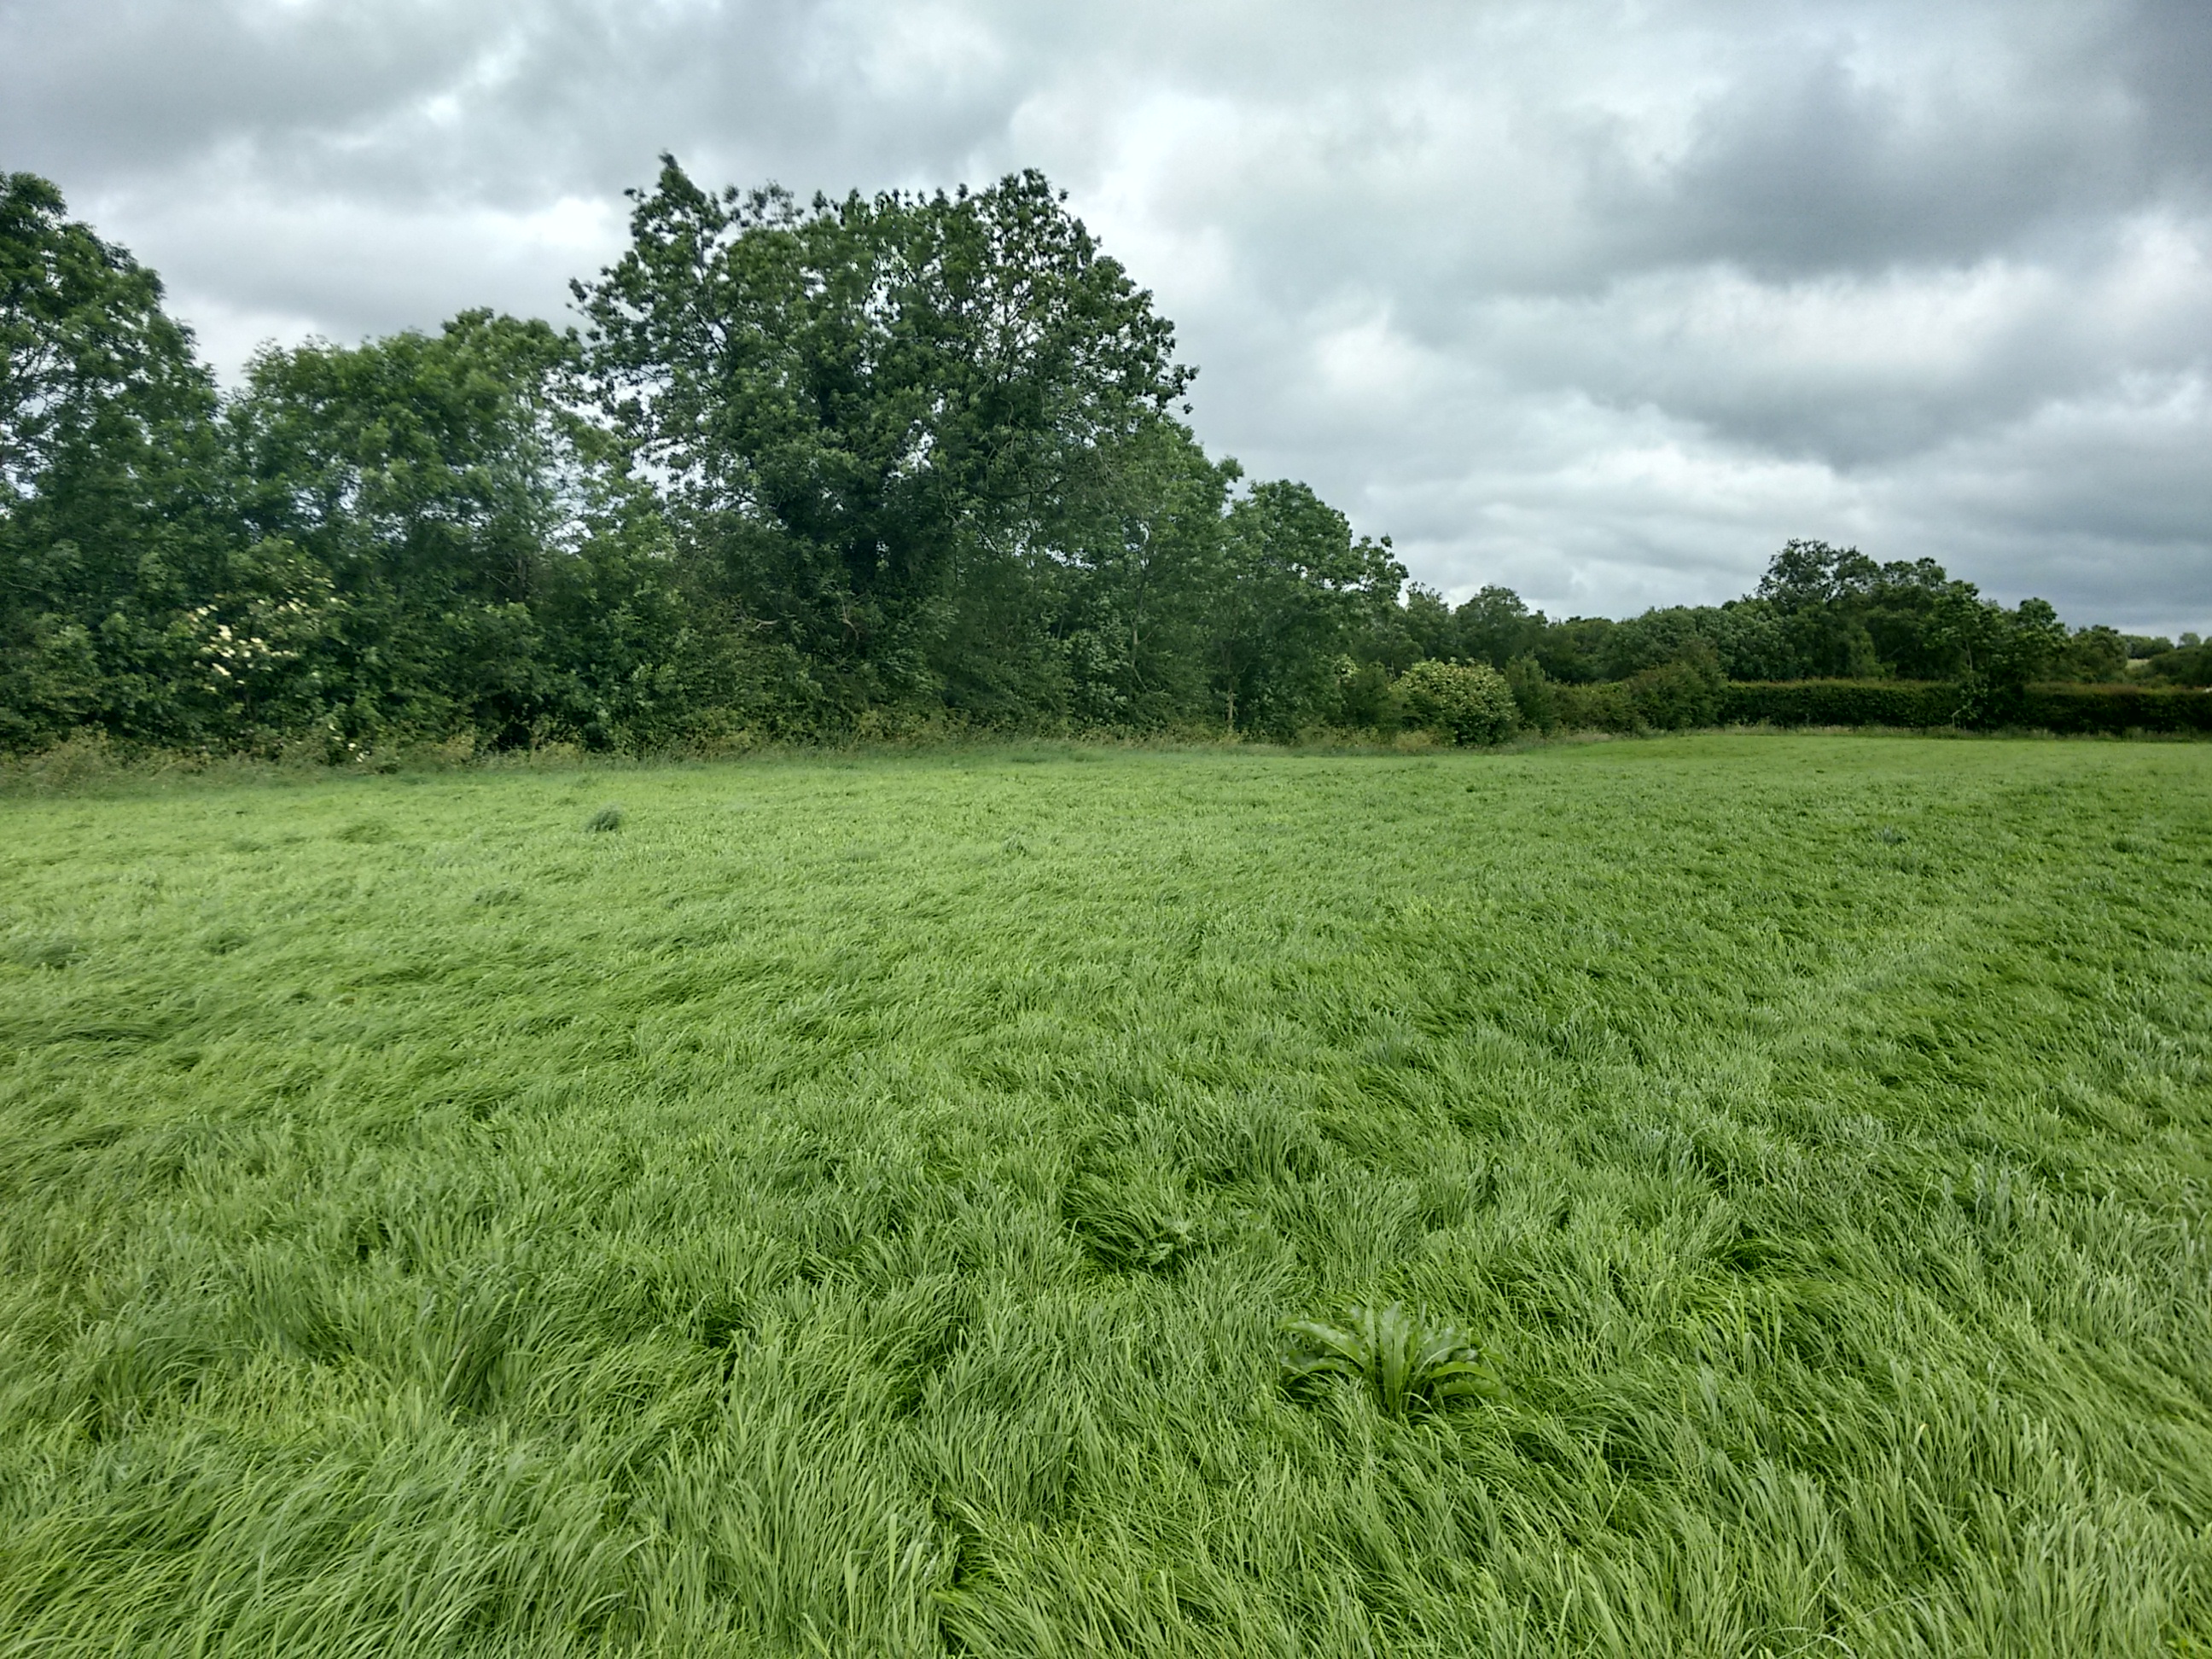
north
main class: Grassland
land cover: Grassland without tree/shrub cover
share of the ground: > 75 %
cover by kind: herbaceous plants 100 %
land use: Agriculture (excluding fallow land and kitchen gardens)
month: July
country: GB
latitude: 54.5604
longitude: -7.1390
